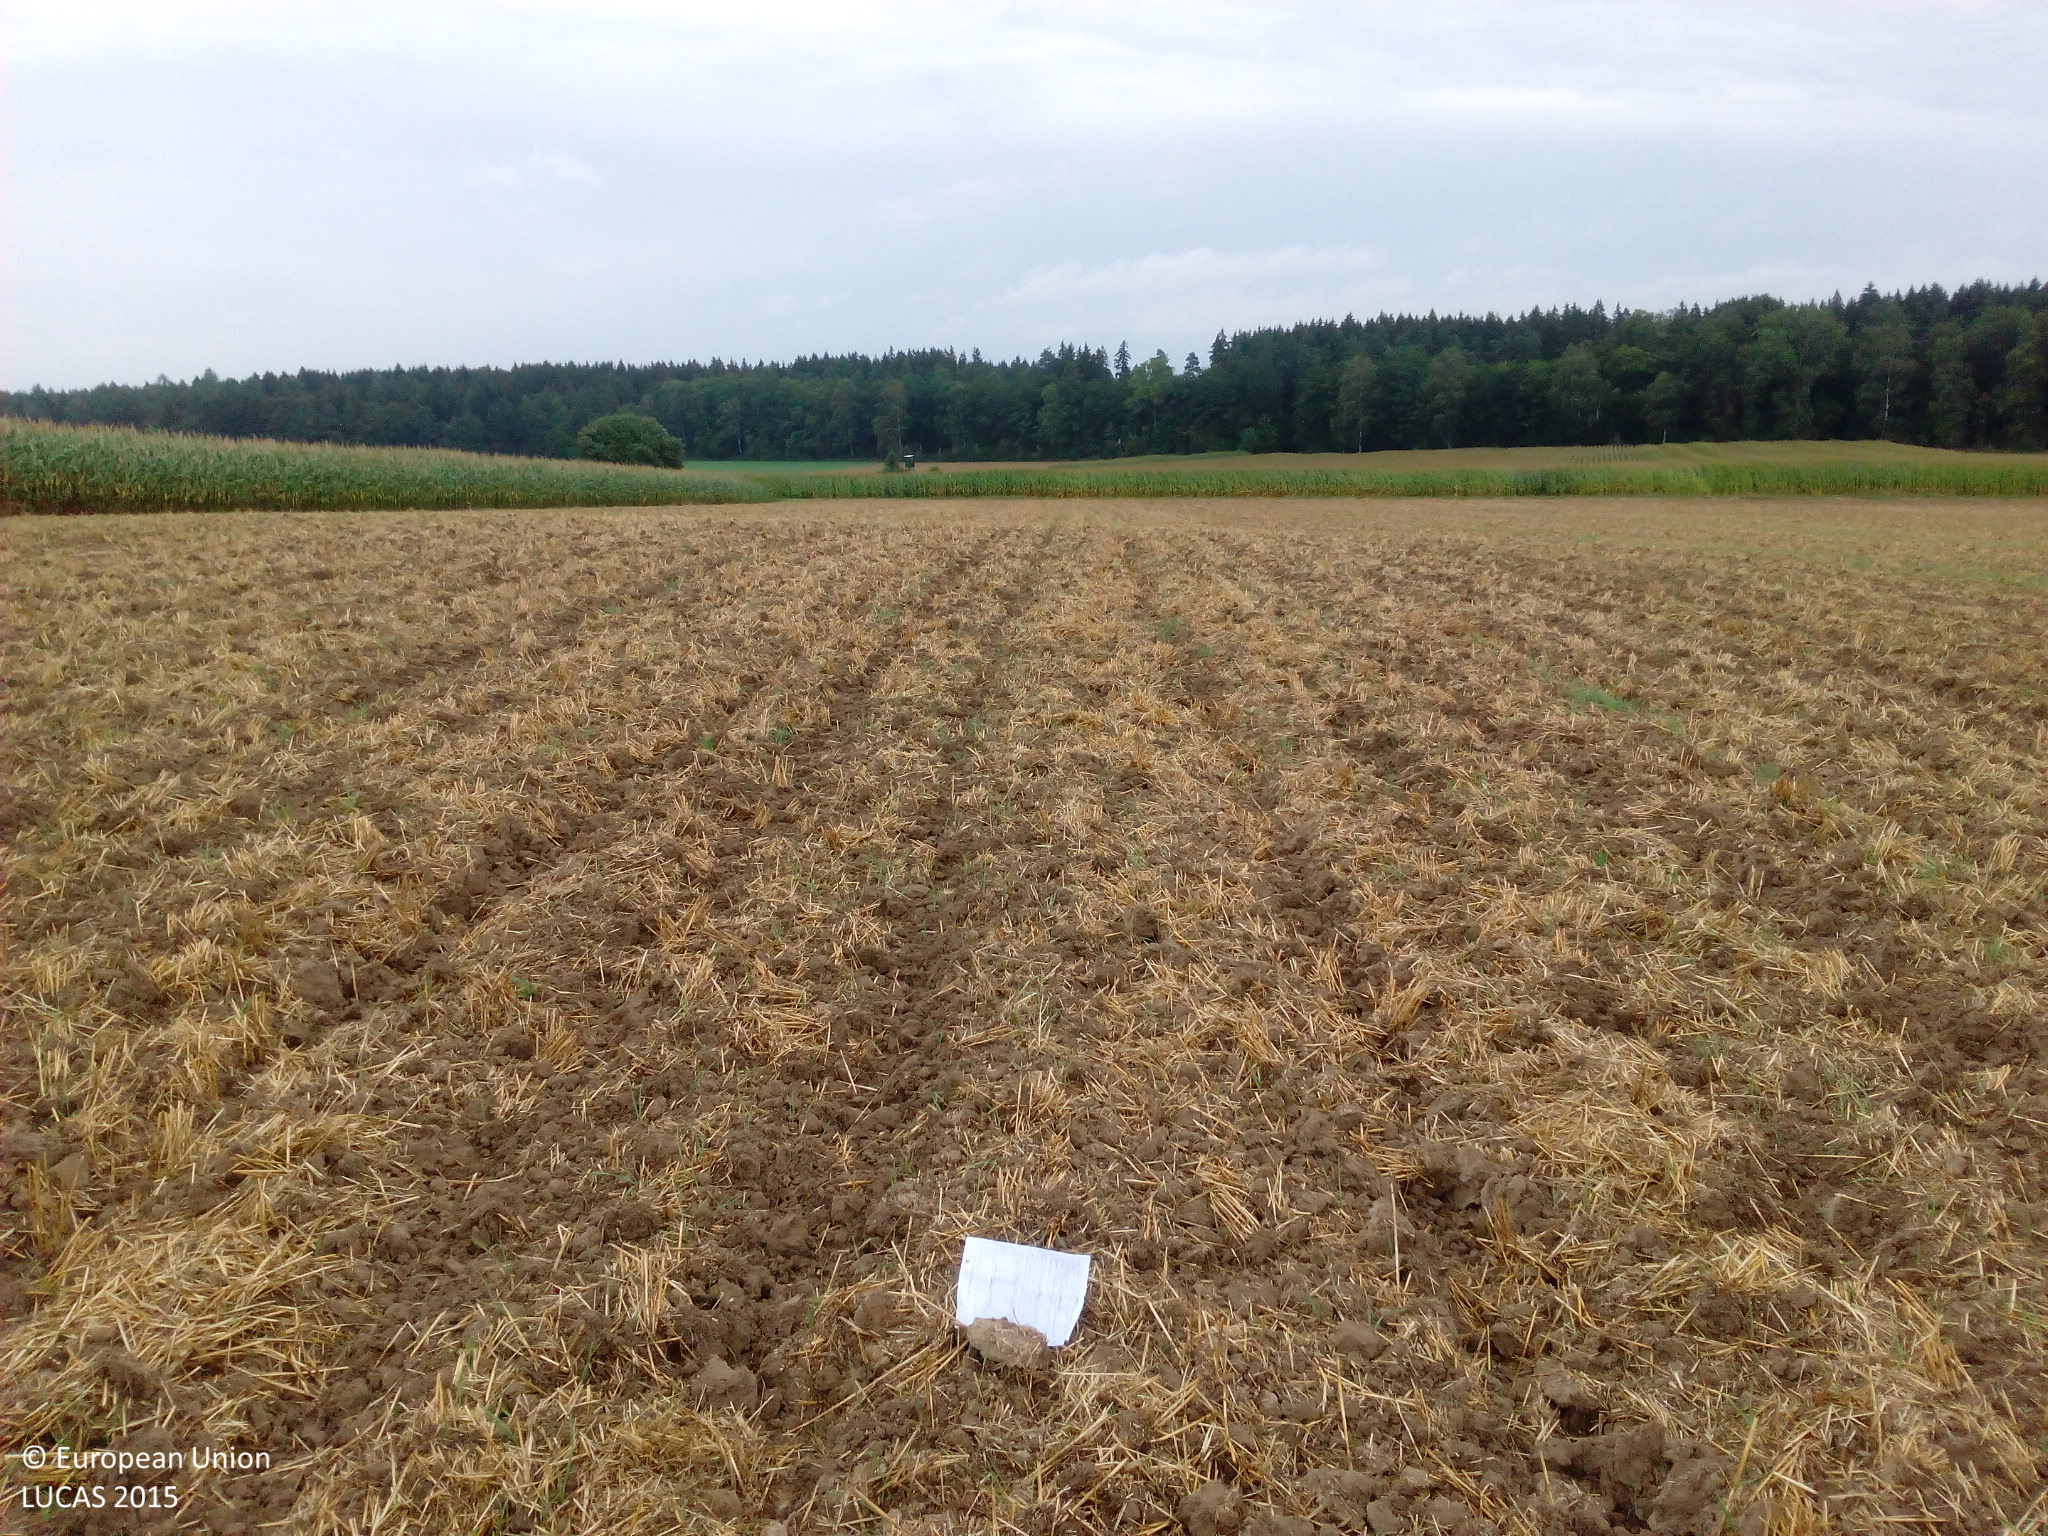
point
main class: Cropland
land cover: Common wheat
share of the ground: < 10 %
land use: Agriculture (excluding fallow land and kitchen gardens)
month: September
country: DE
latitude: 48.2952
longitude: 10.2560
